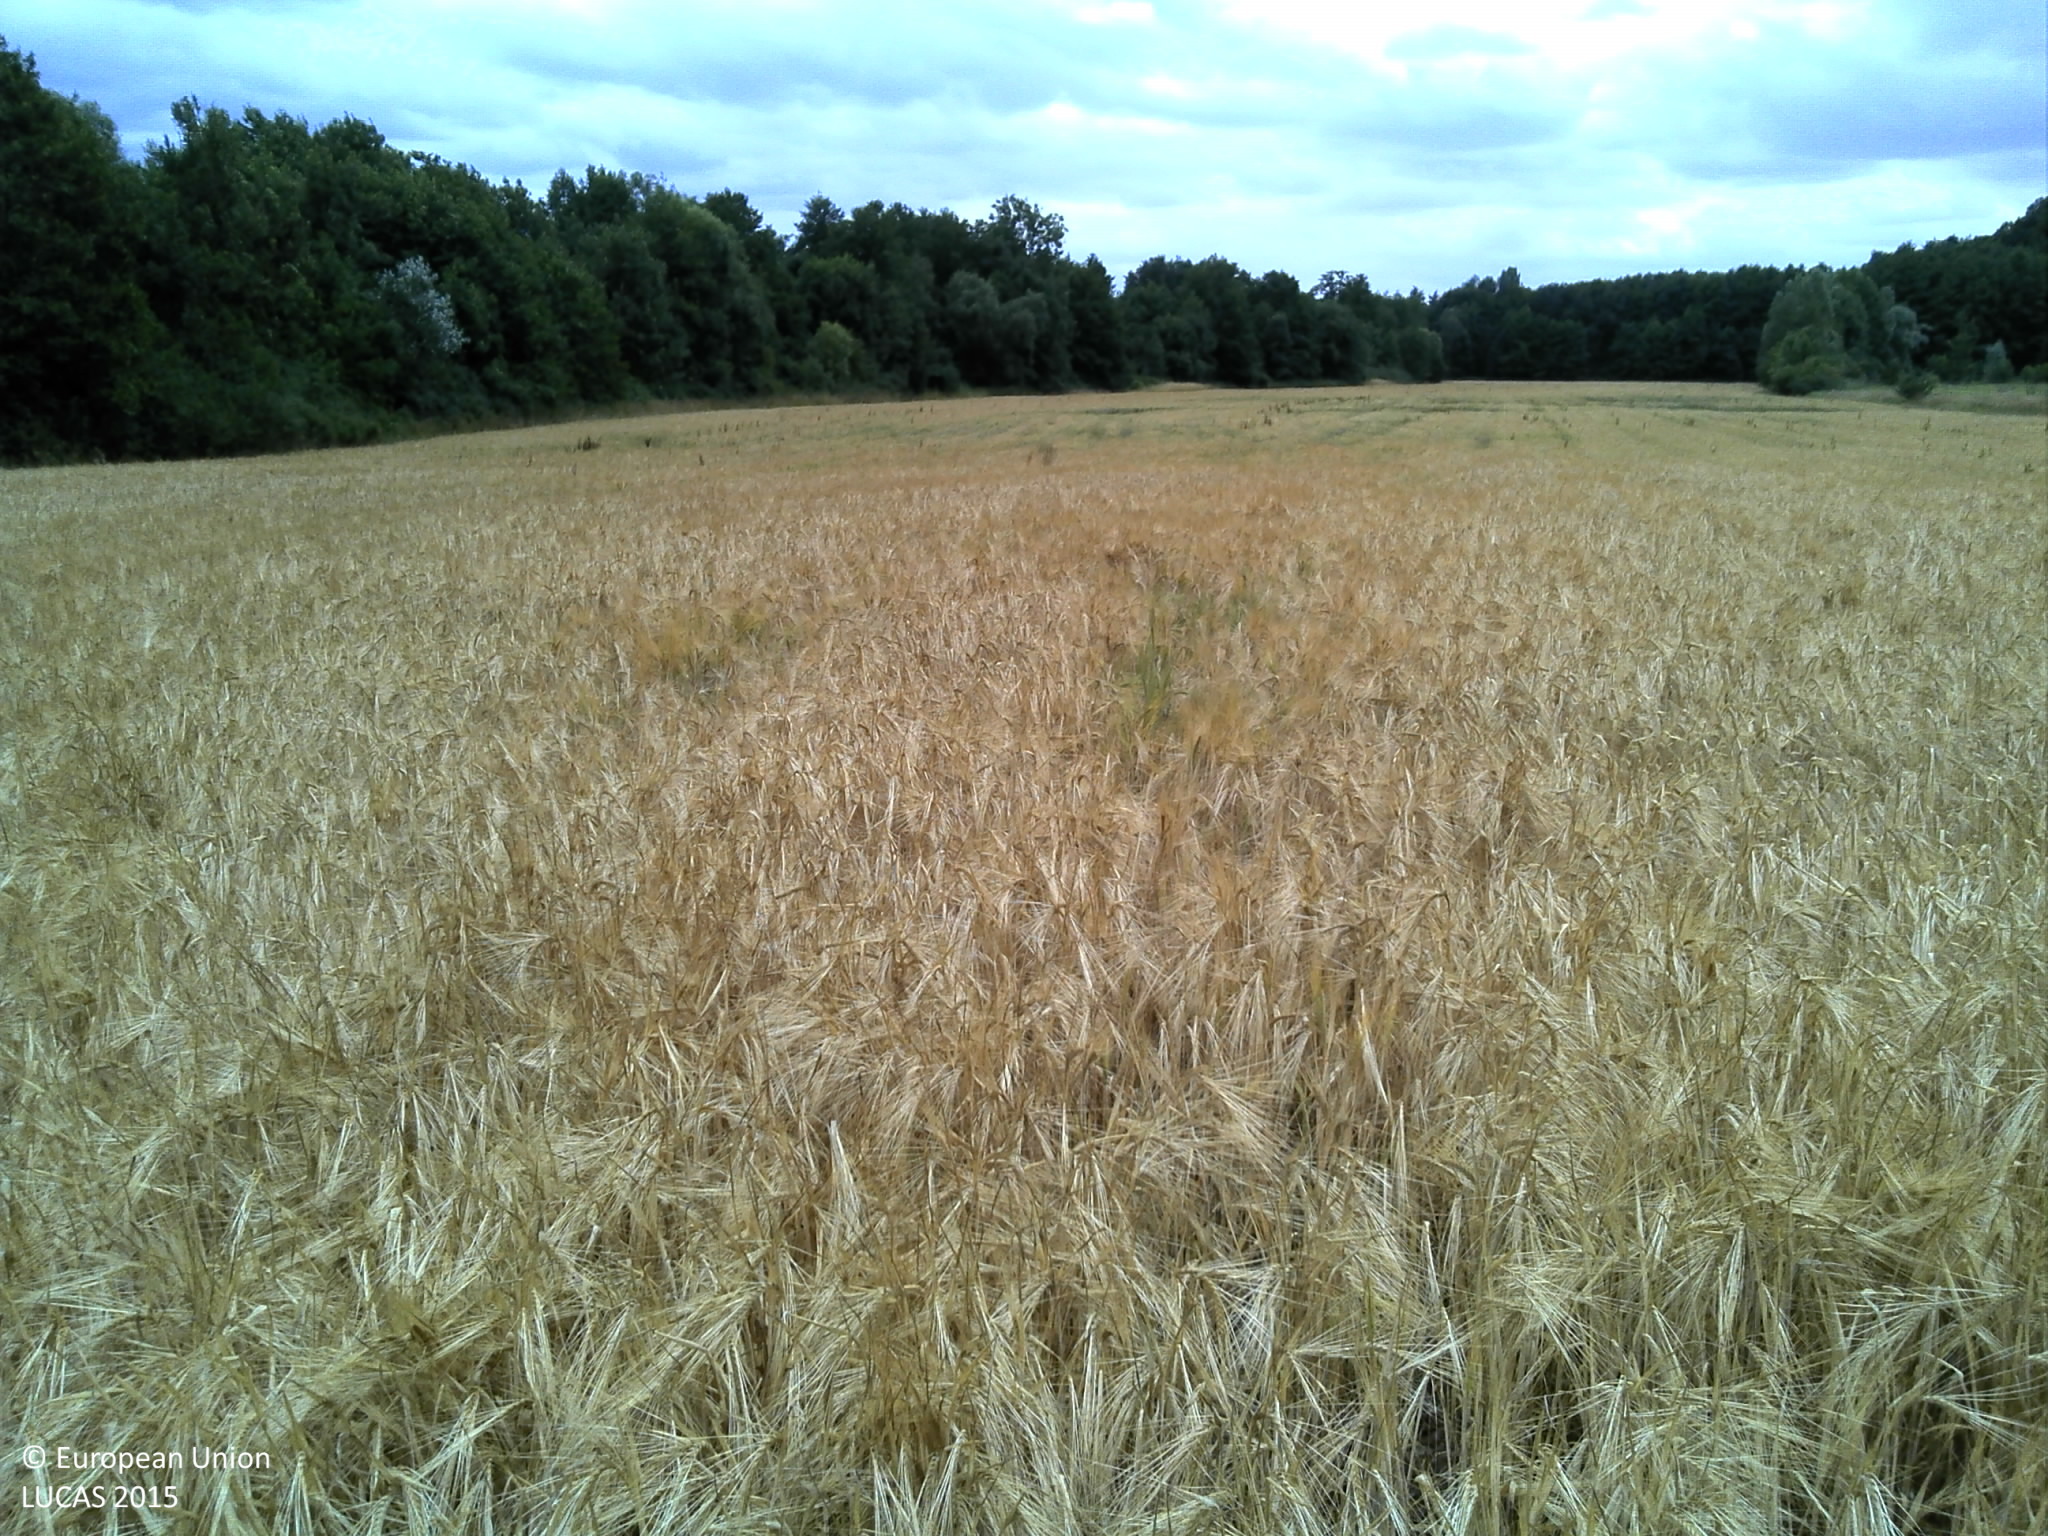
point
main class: Cropland
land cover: Rye
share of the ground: > 75 %
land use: Agriculture (excluding fallow land and kitchen gardens)
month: July
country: FR
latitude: 49.1862
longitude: 4.8798
